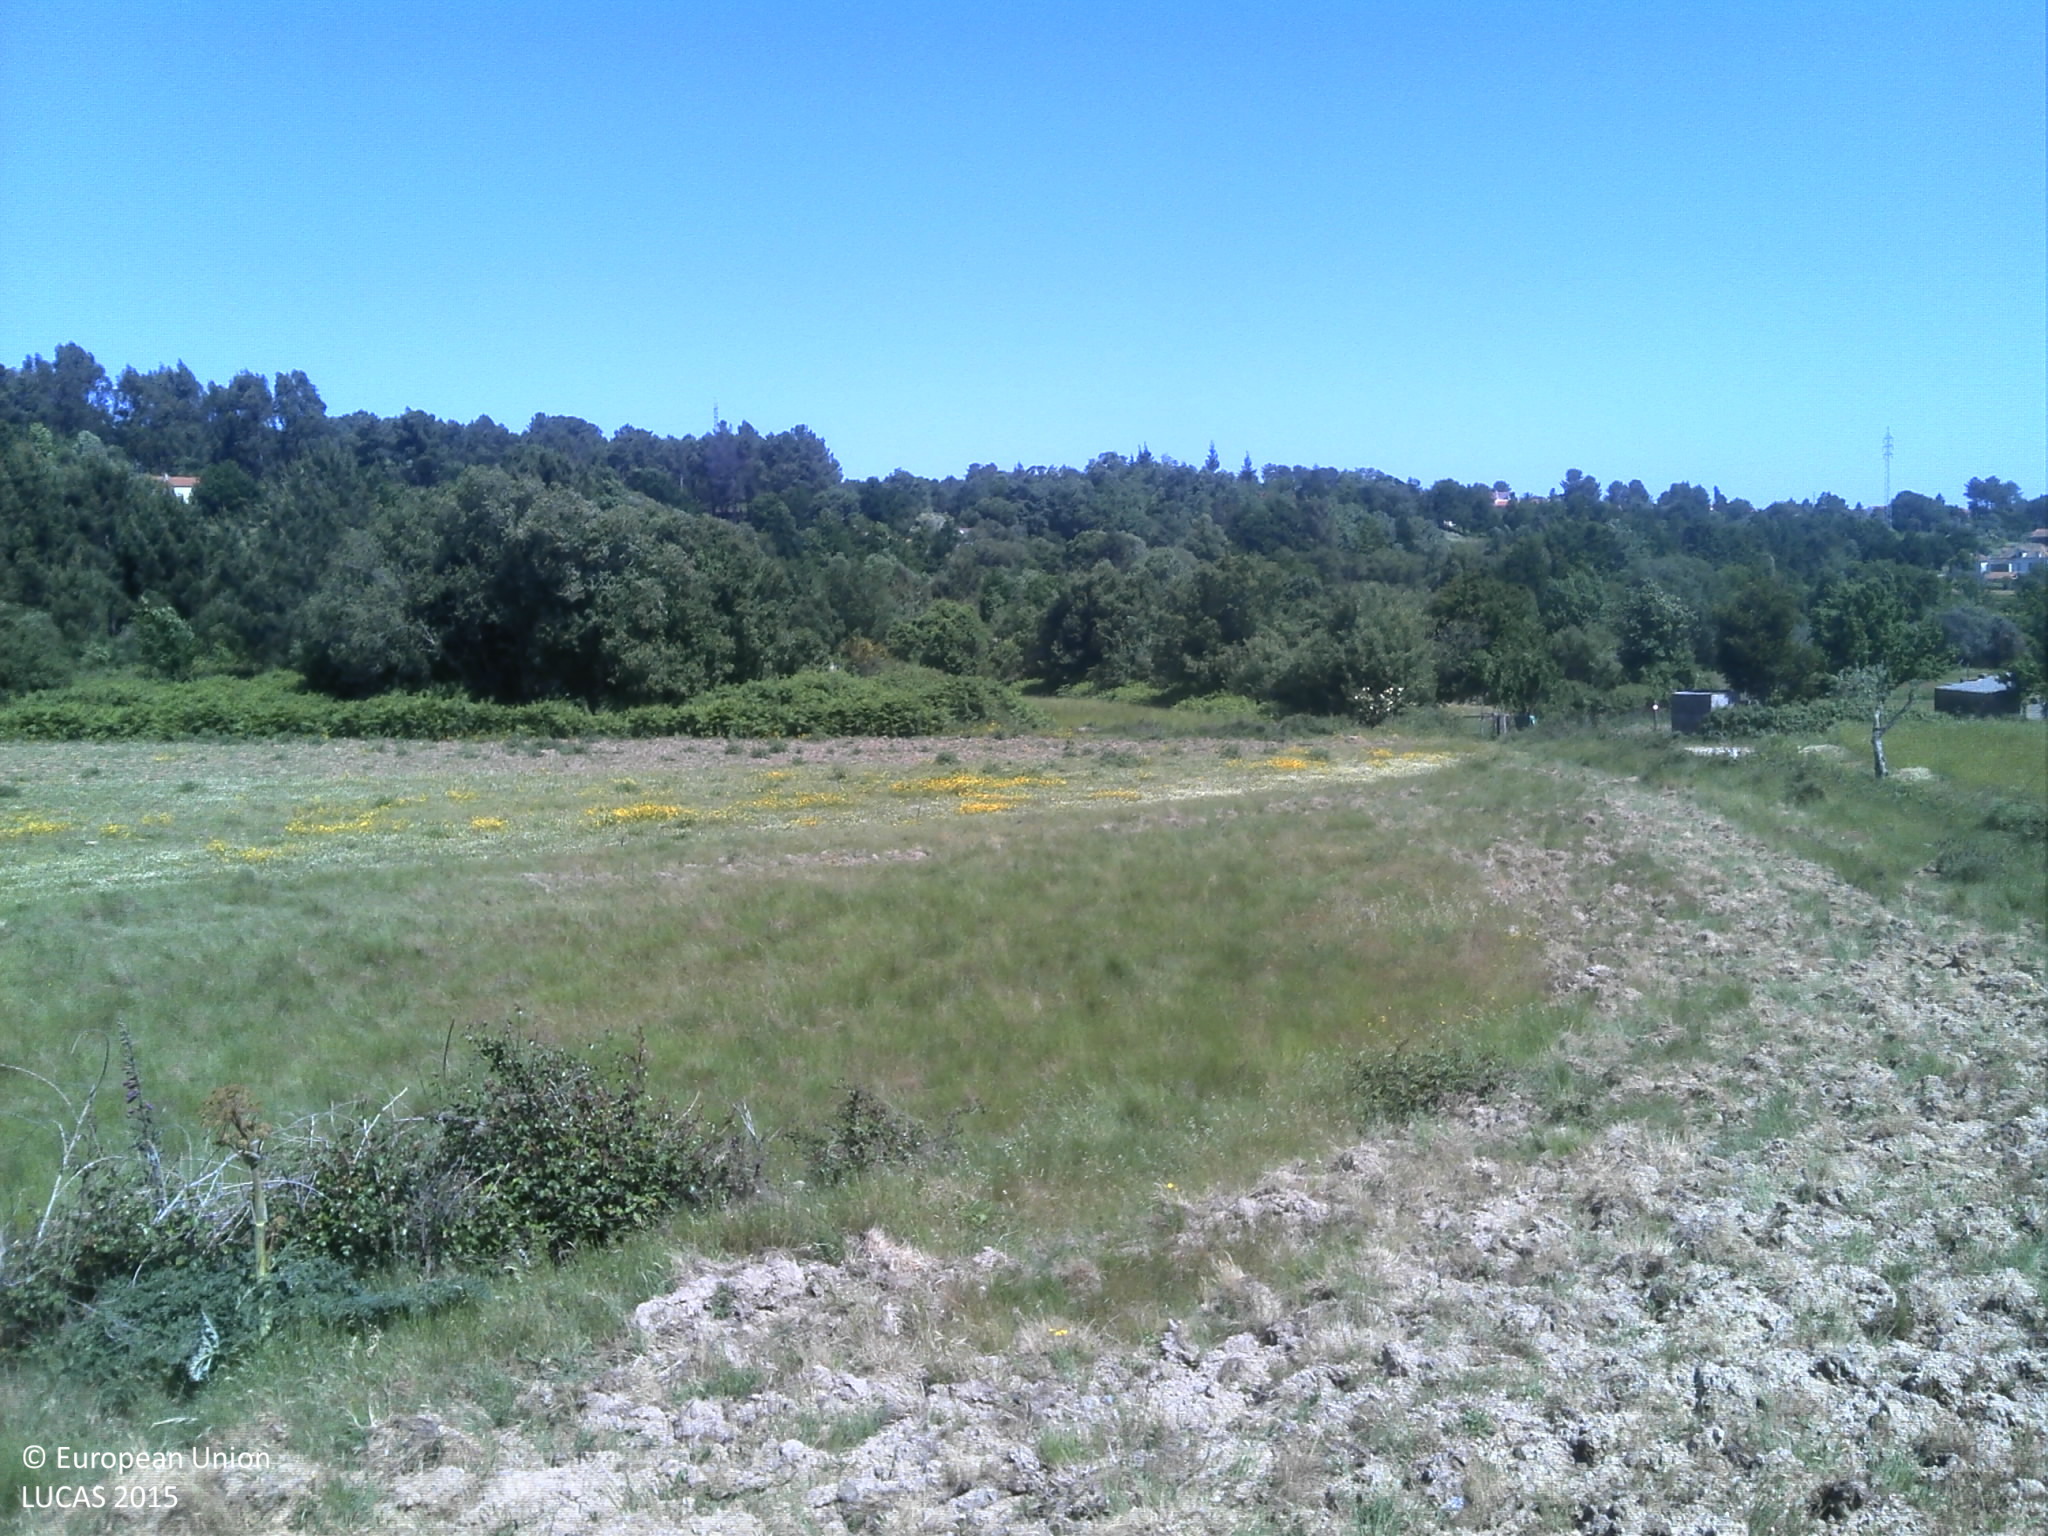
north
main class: Grassland
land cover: Grassland without tree/shrub cover
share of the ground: 25 - 50 %
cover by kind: unconsolidated bare surface 60 %, herbaceous plants 40 %
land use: Agriculture (excluding fallow land and kitchen gardens)
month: May
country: PT
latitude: 40.4102
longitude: -7.7326
